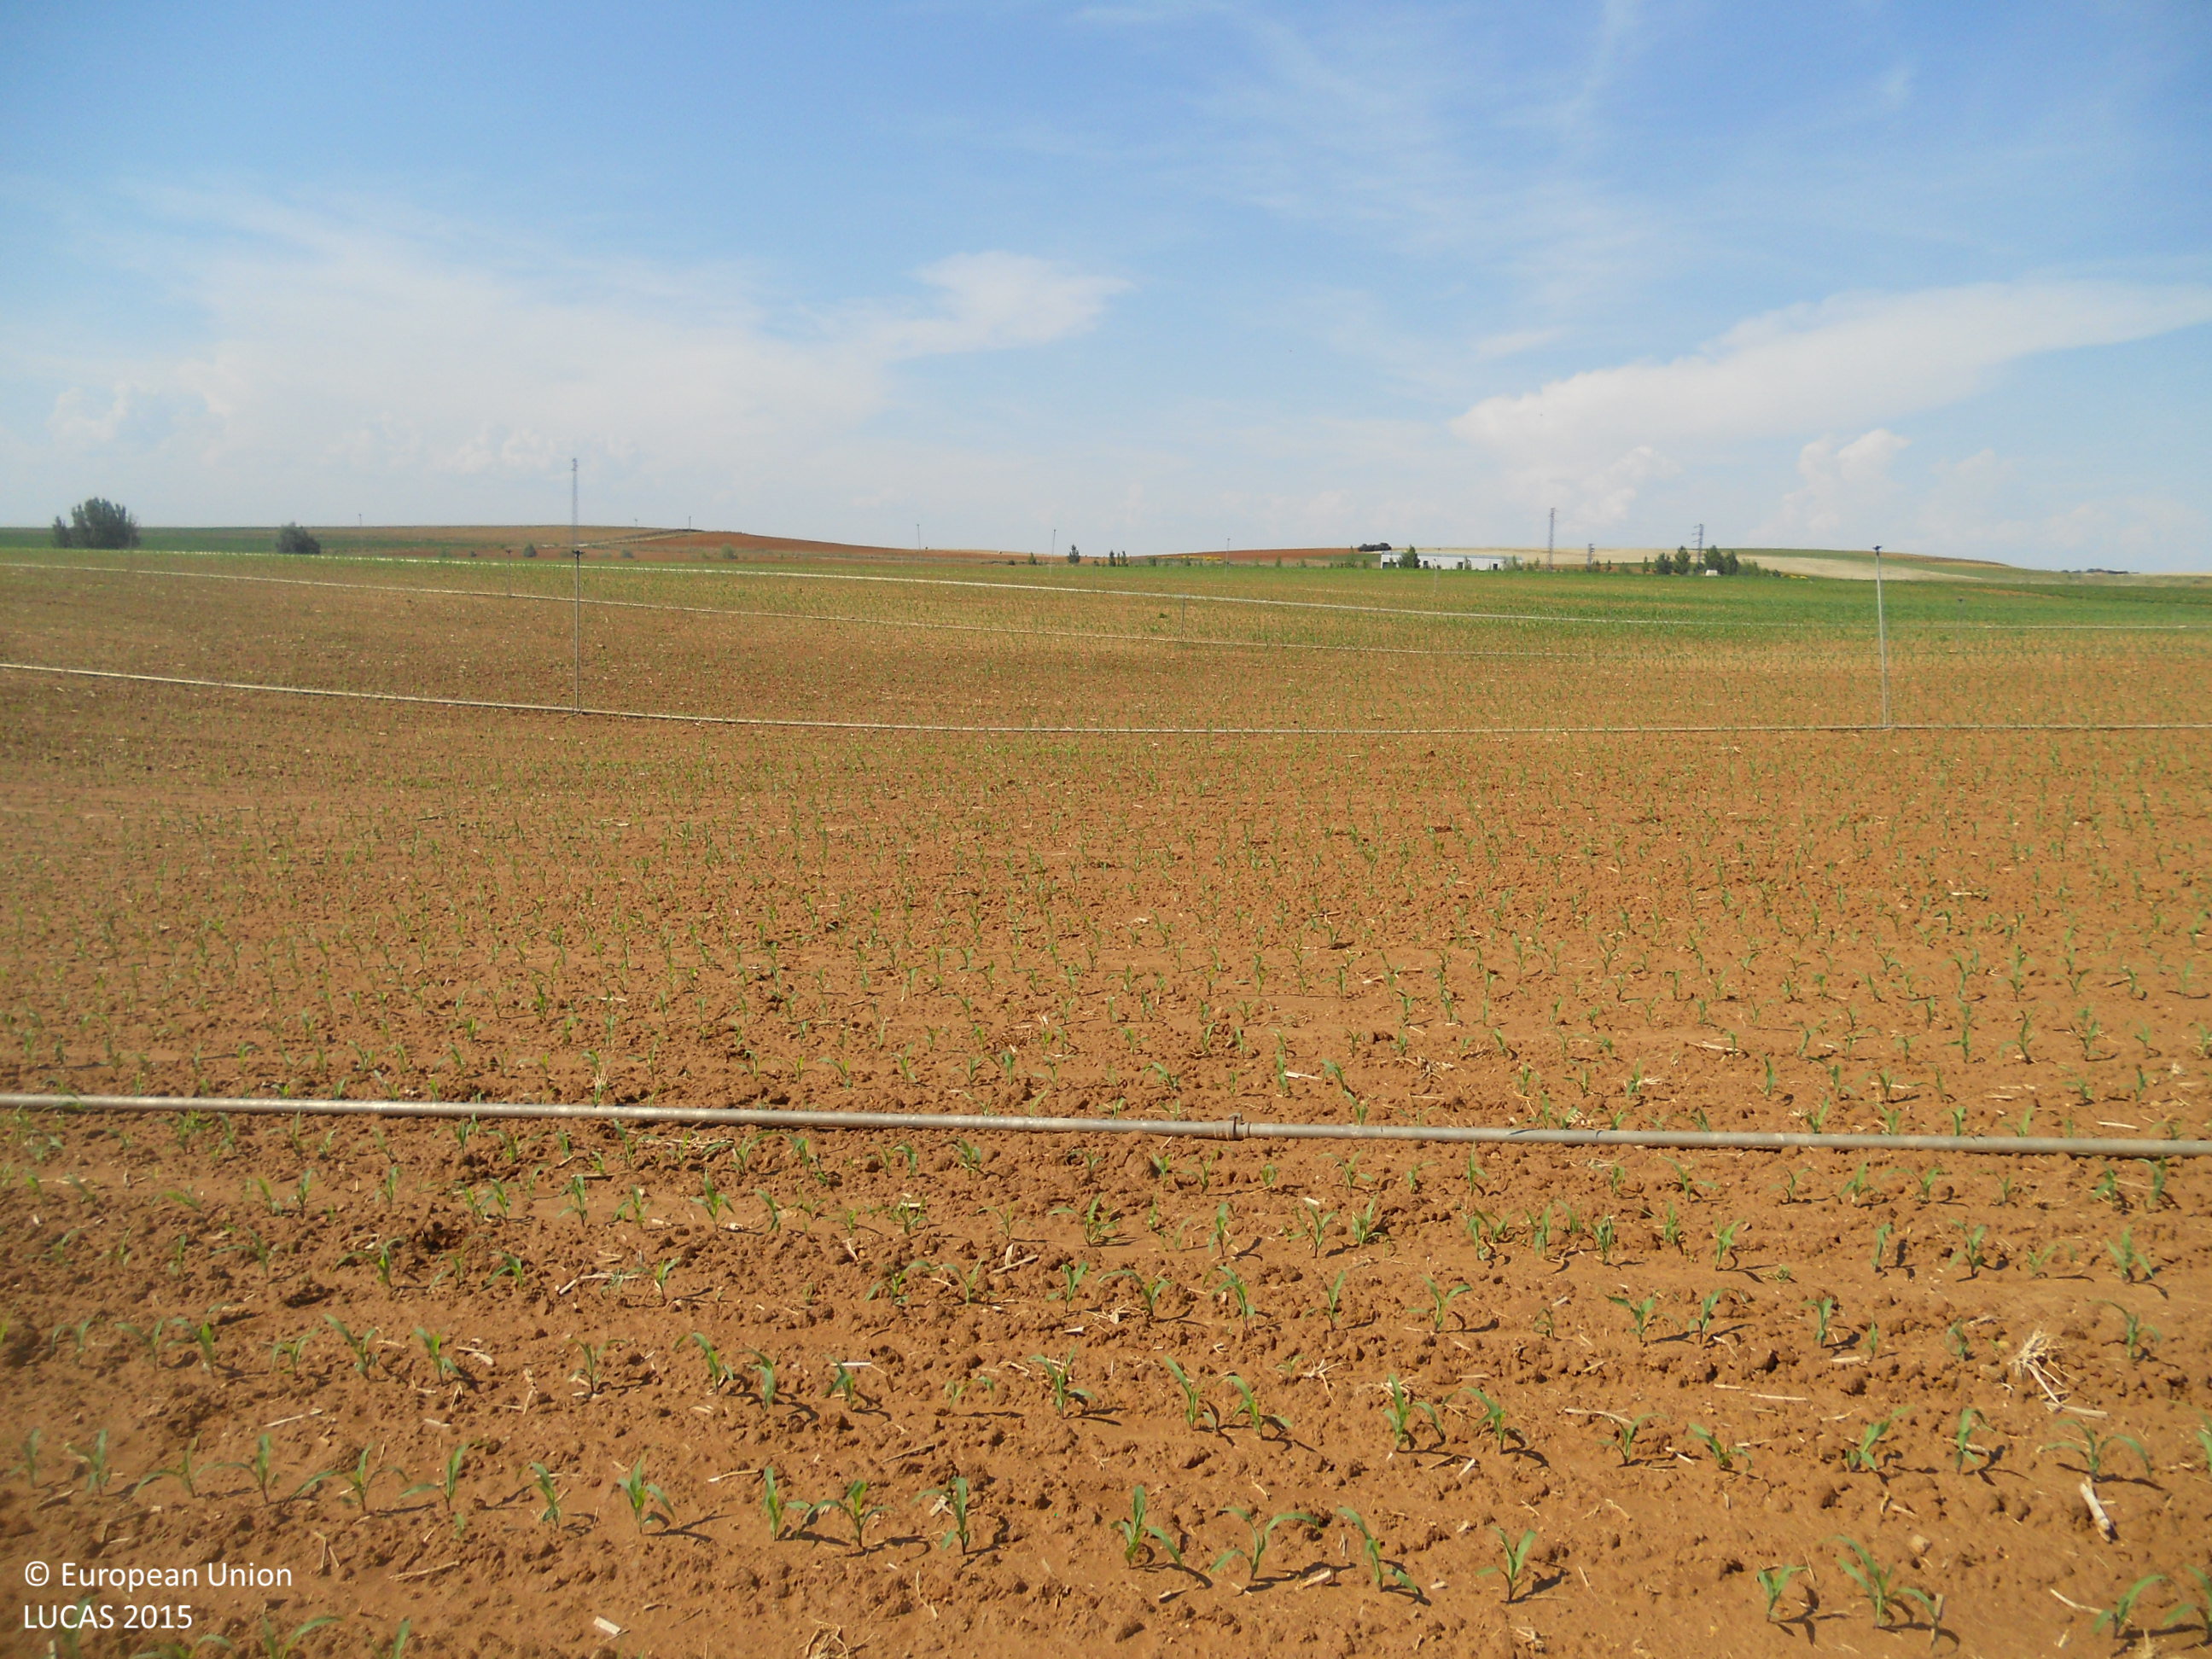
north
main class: Cropland
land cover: Maize
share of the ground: < 10 %
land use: Agriculture (excluding fallow land and kitchen gardens)
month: June
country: ES
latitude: 42.2036
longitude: -5.5088
